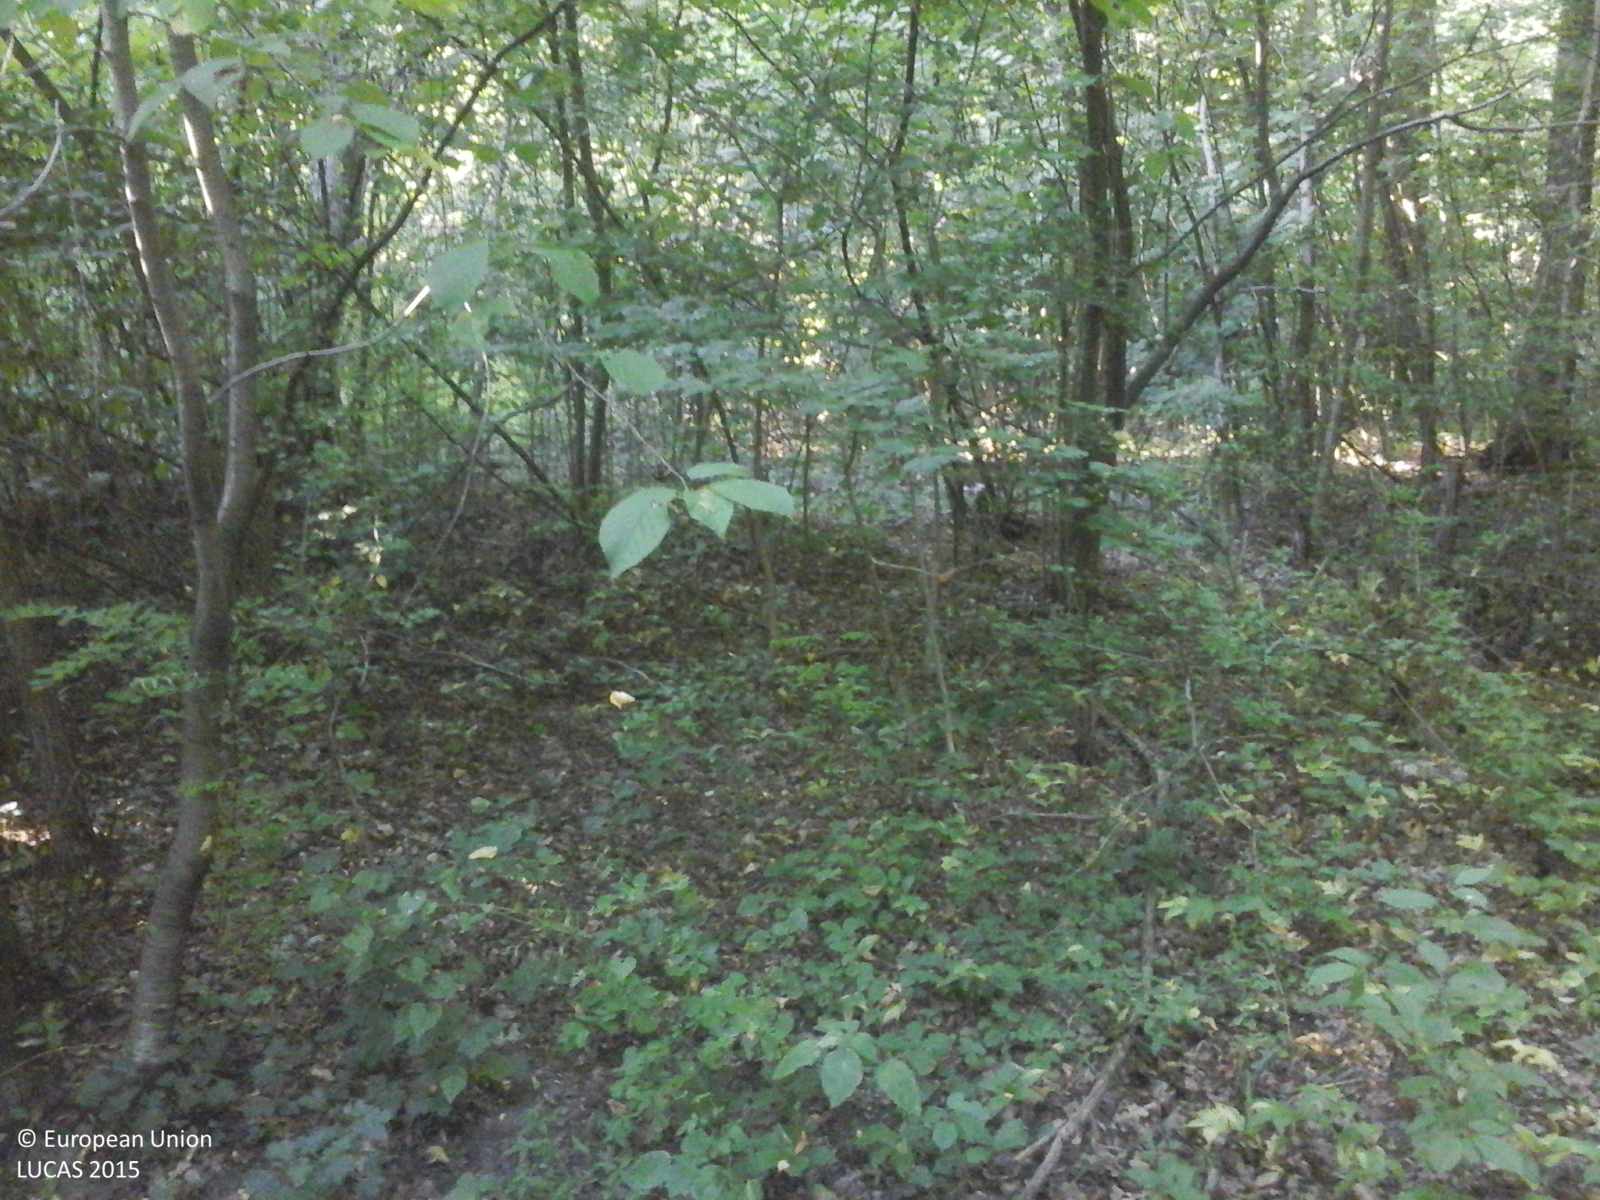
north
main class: Woodland
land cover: Broadleaved woodland
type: beech forest
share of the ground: > 75 %
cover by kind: broadleaved forest trees 95 %, herbaceous plants 5 %
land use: Forestry
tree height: > 5 m
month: July
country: RO
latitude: 45.0126
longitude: 24.7356
